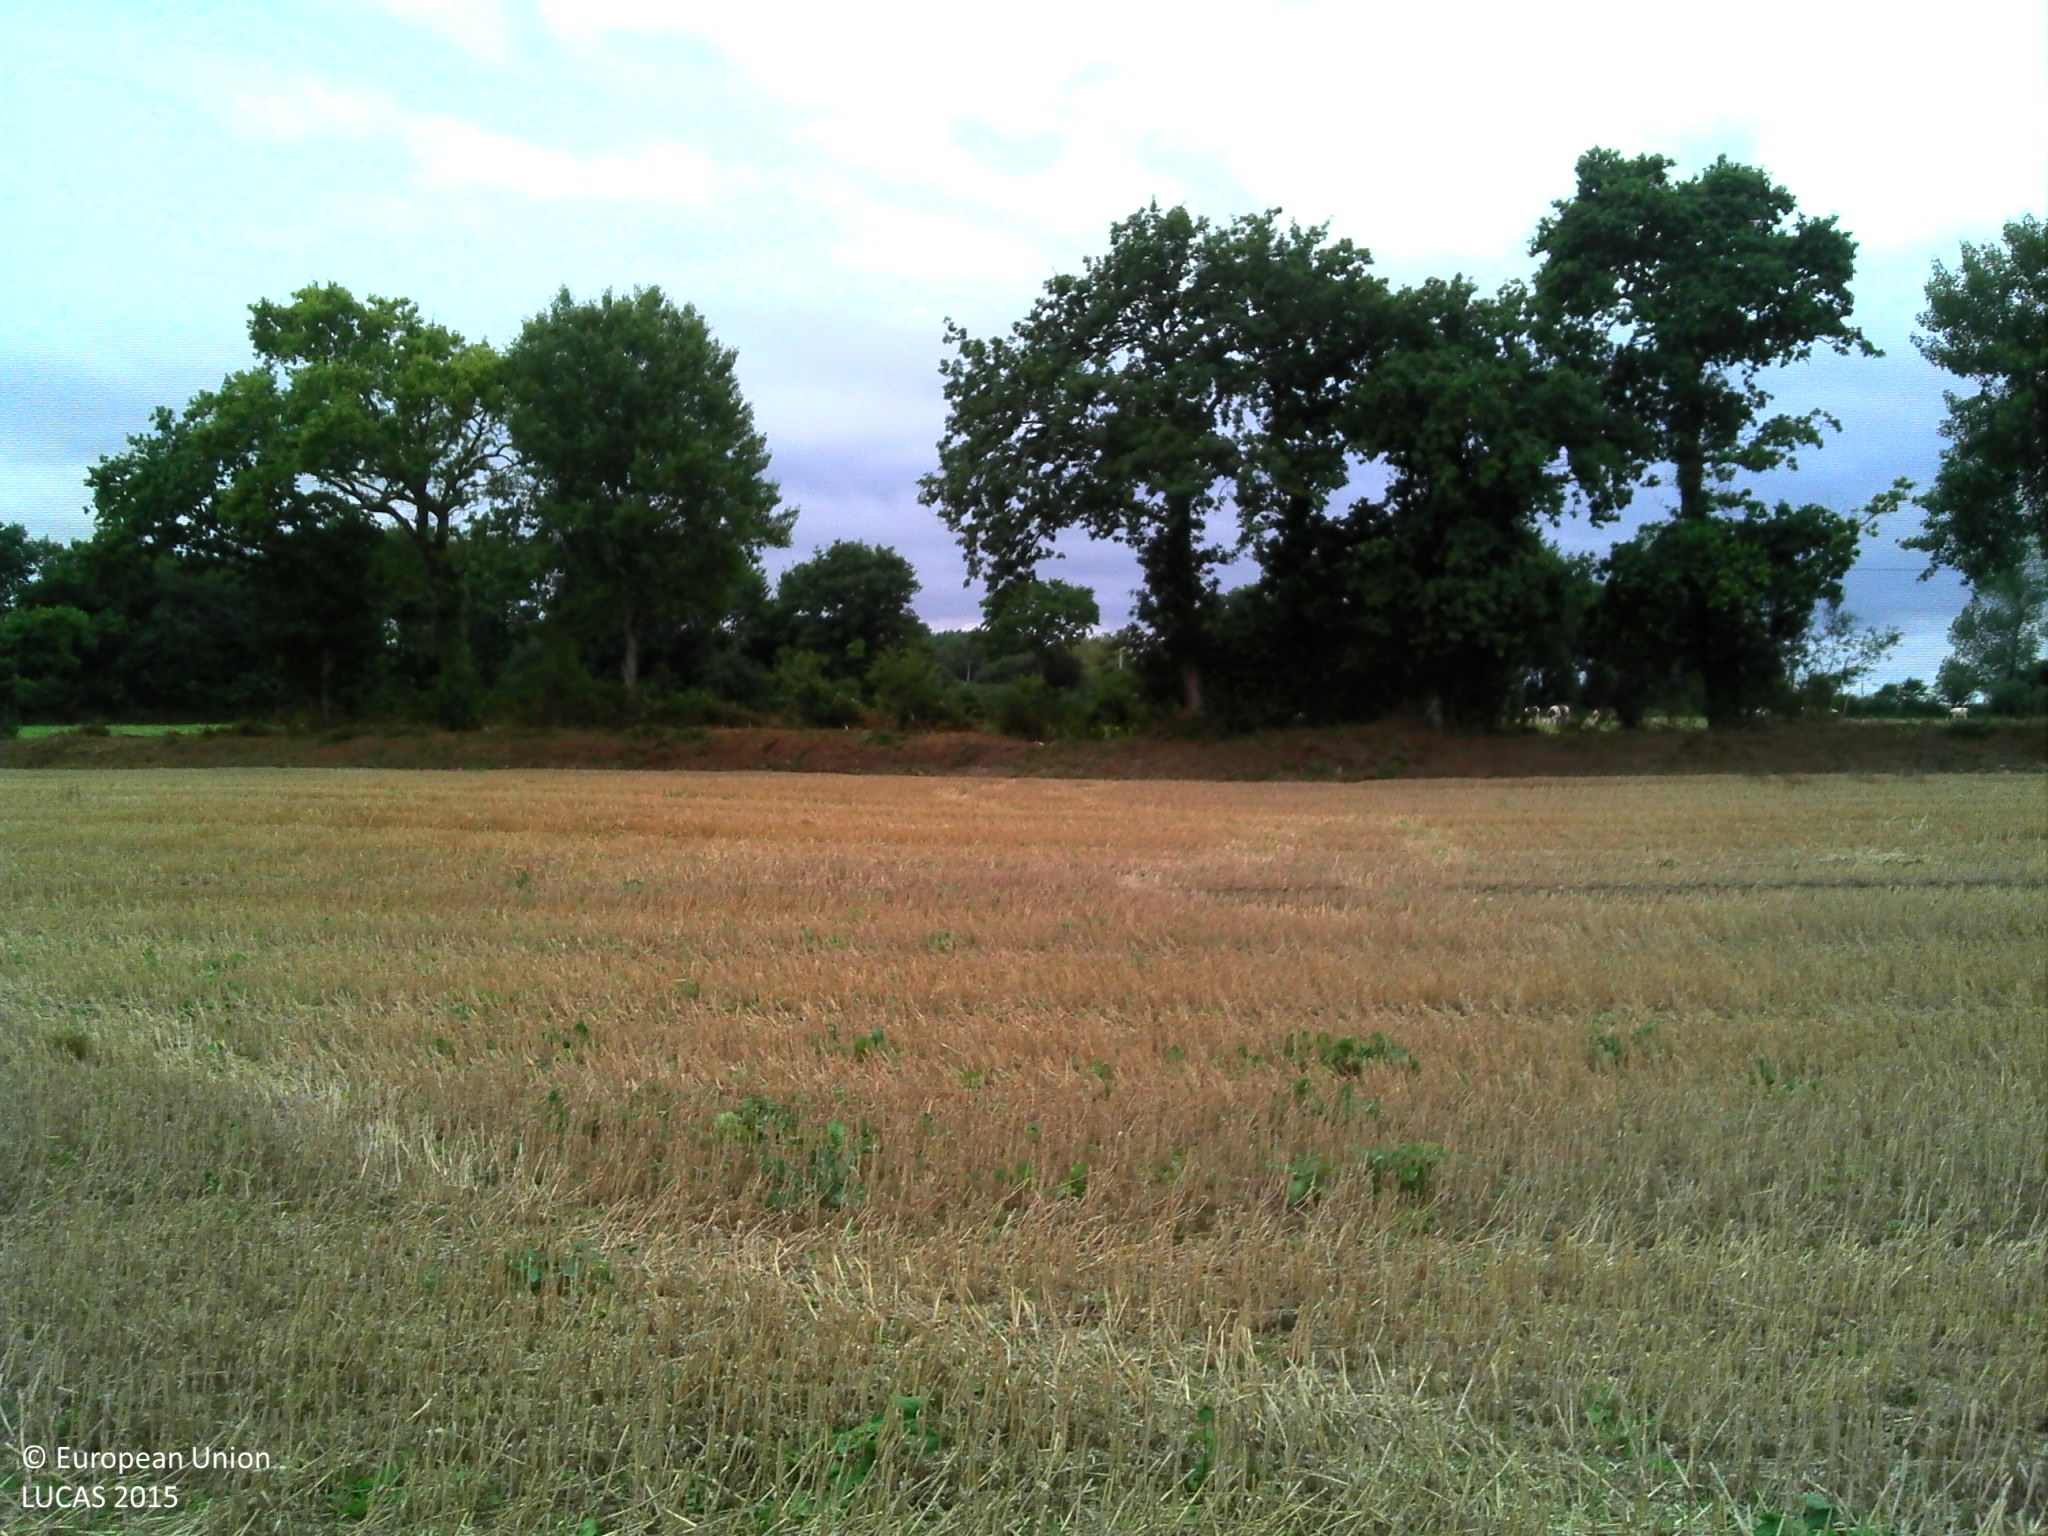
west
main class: Cropland
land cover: Common wheat
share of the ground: > 75 %
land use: Agriculture (excluding fallow land and kitchen gardens)
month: August
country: FR
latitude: 48.6824
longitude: -3.2086
